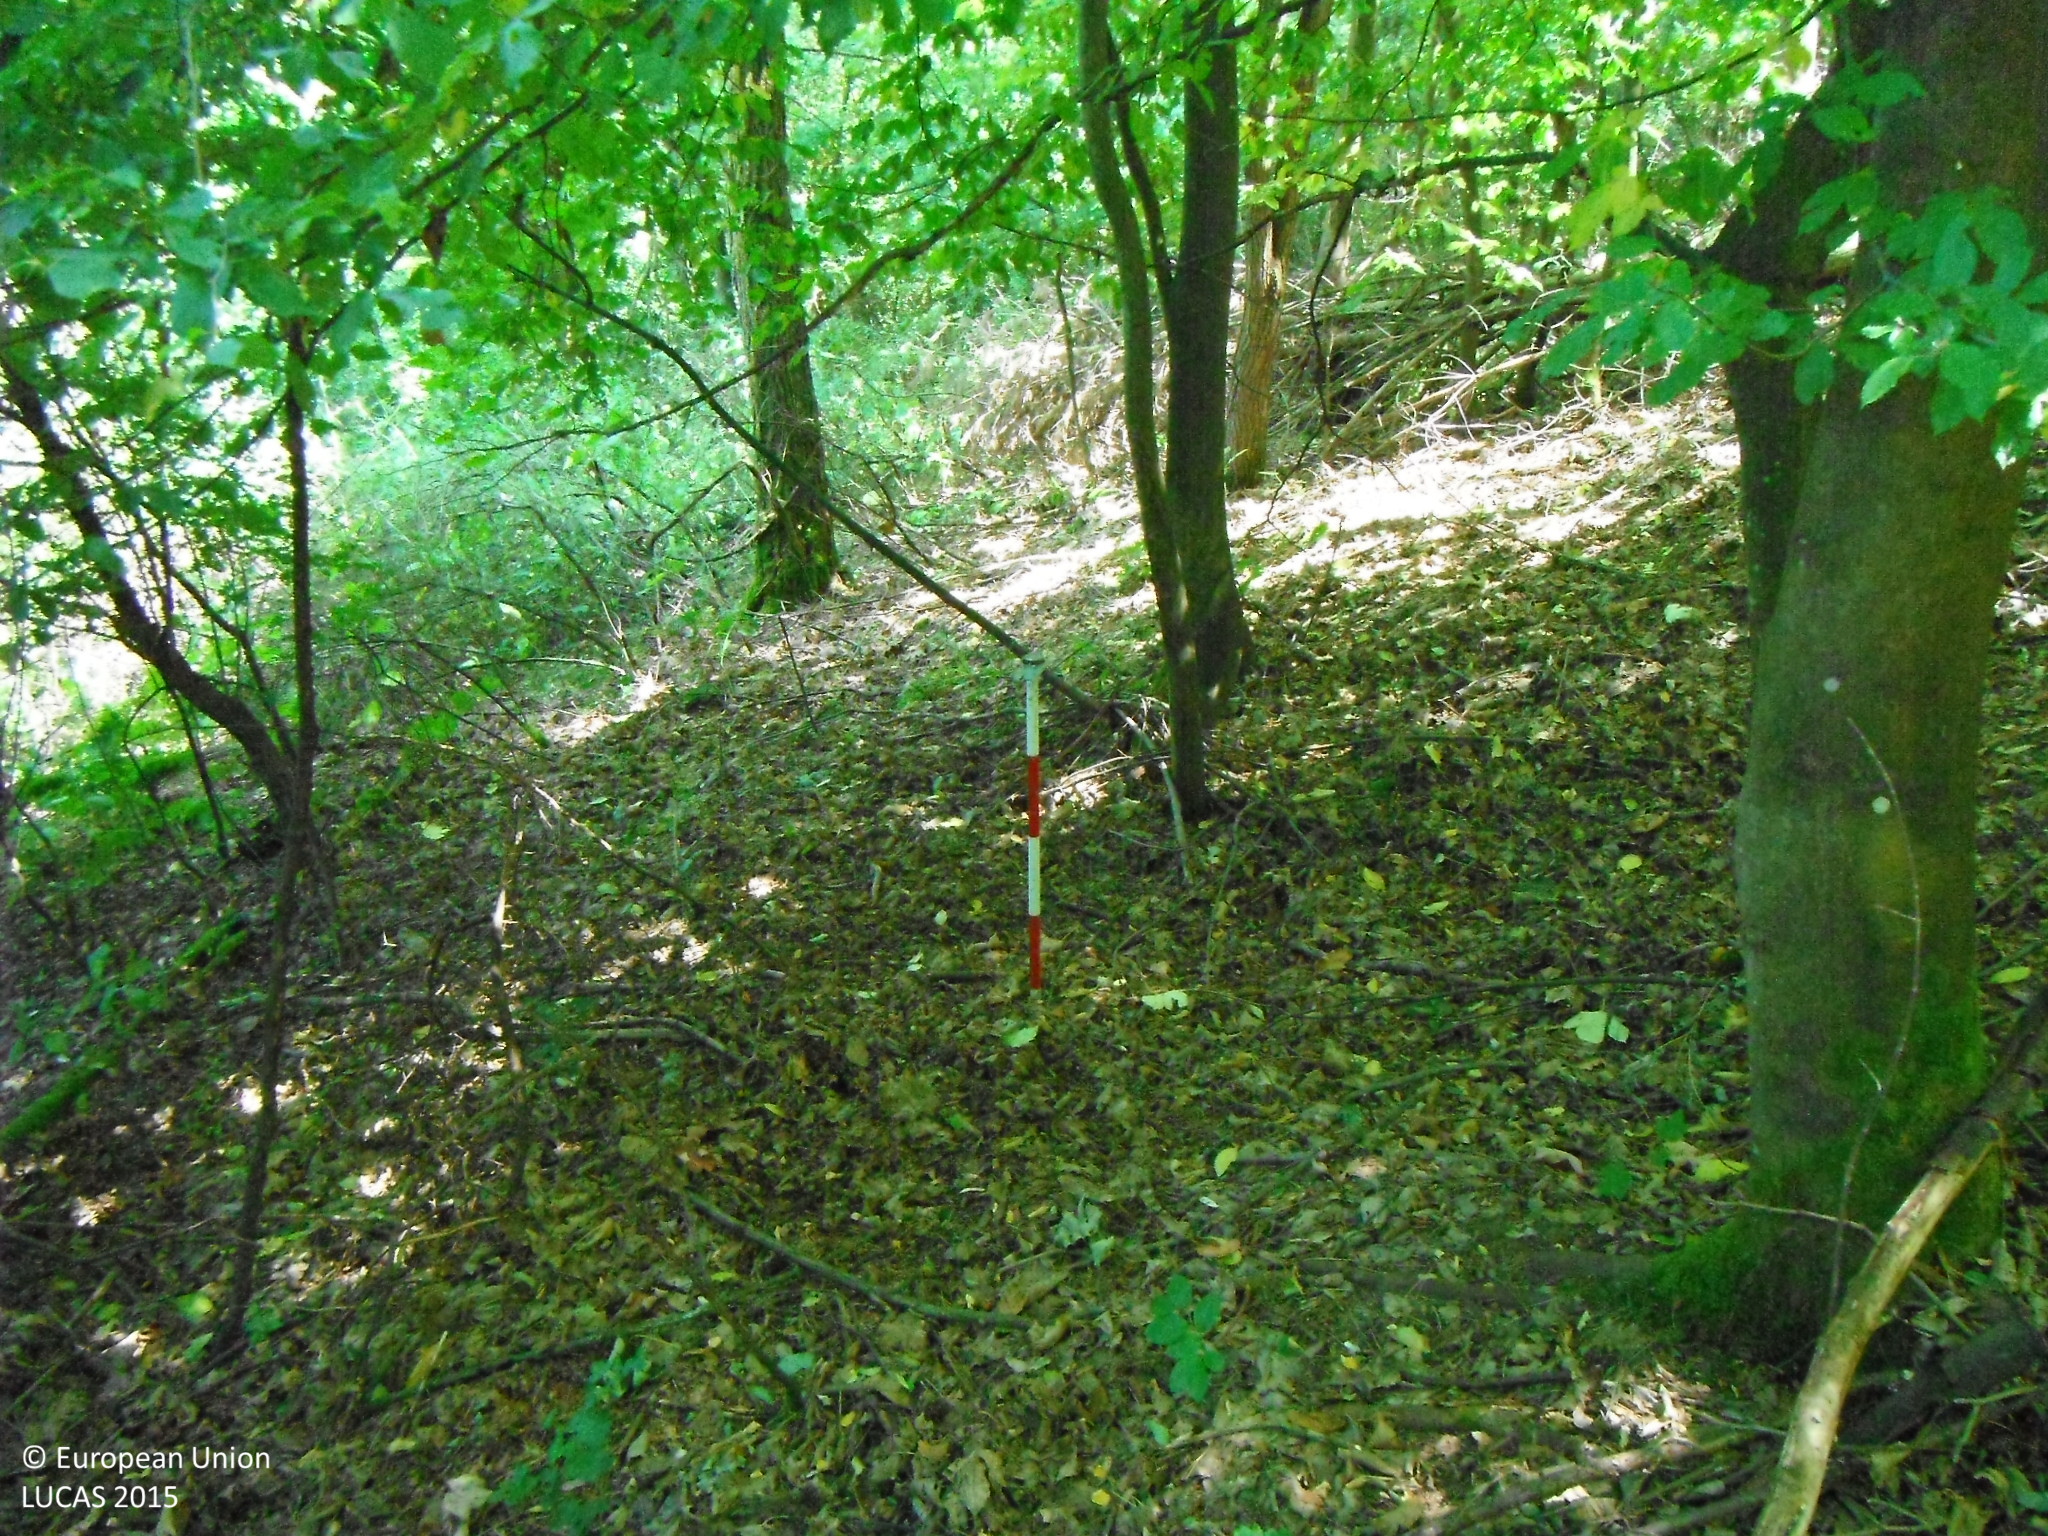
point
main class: Woodland
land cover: Broadleaved woodland
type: mesophytic deciduous forest
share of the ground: > 75 %
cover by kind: broadleaved forest trees 100 %
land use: Forestry
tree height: > 5 m
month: July
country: SK
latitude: 48.2005
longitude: 20.0257
